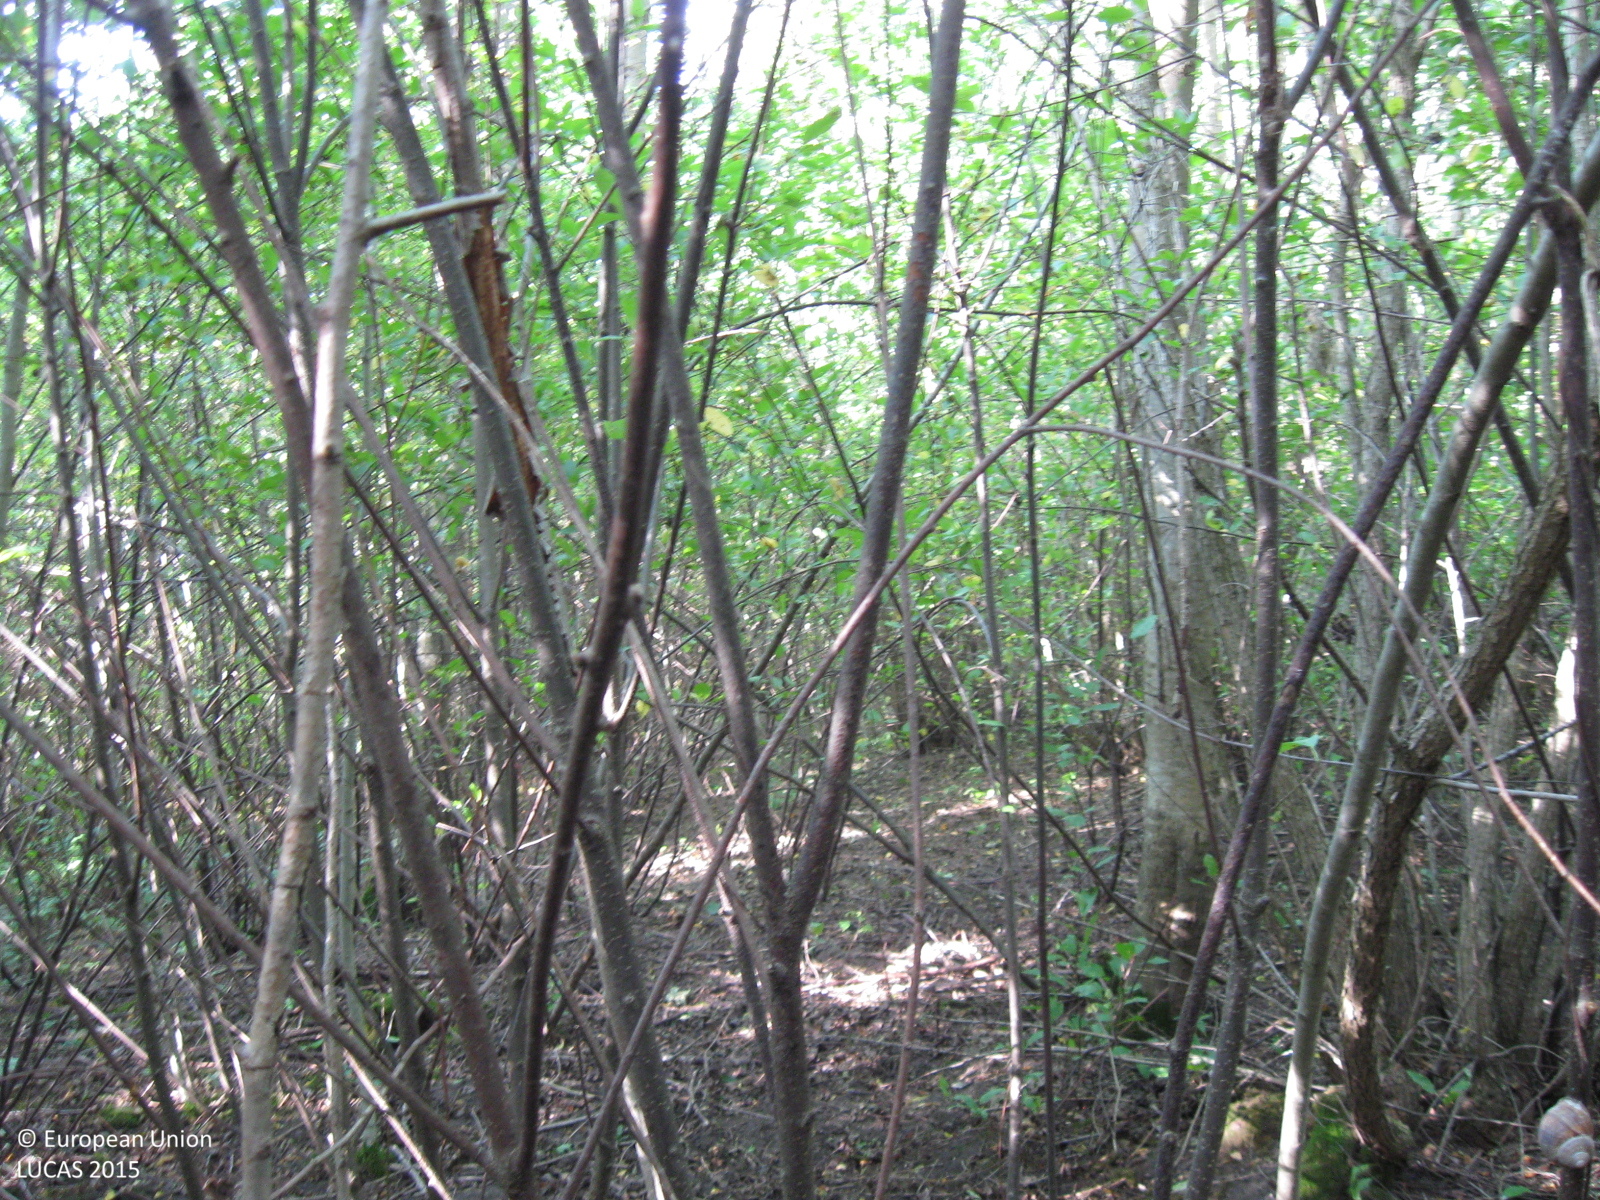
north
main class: Woodland
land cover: Broadleaved woodland
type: non-riverine alder, birch or aspen forest
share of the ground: > 75 %
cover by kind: broadleaved forest trees 95 %, unconsolidated bare surface 5 %
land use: Forestry
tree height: > 5 m
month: August
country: LT
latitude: 55.4636
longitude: 23.2169
